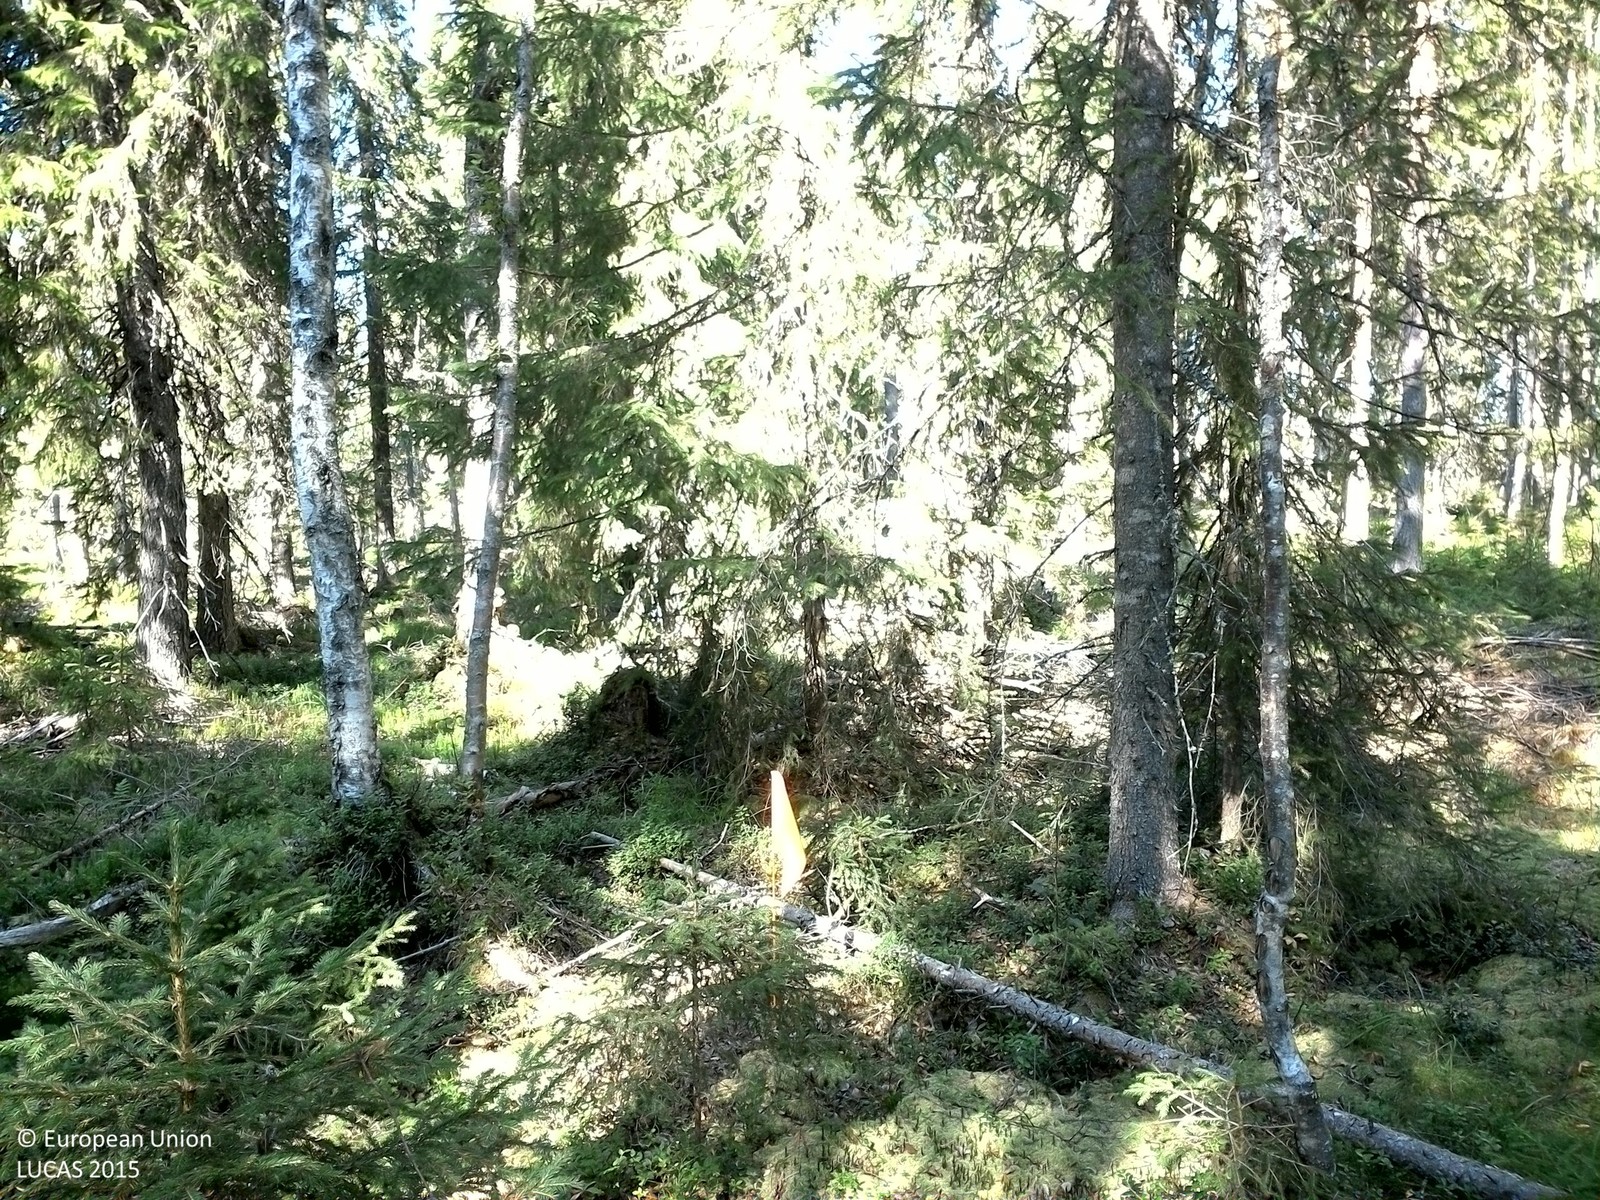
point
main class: Woodland
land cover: Spruce dominated mixed woodland
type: boreal forest
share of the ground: 50 - 75 %
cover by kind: coniferous forest trees 40 %, broadleaved forest trees 30 %, lichens and mosses 15 %, shrubs 10 %, herbaceous plants 5 %
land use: Forestry
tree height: > 5 m
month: August
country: SE
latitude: 63.7052
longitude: 17.2766
